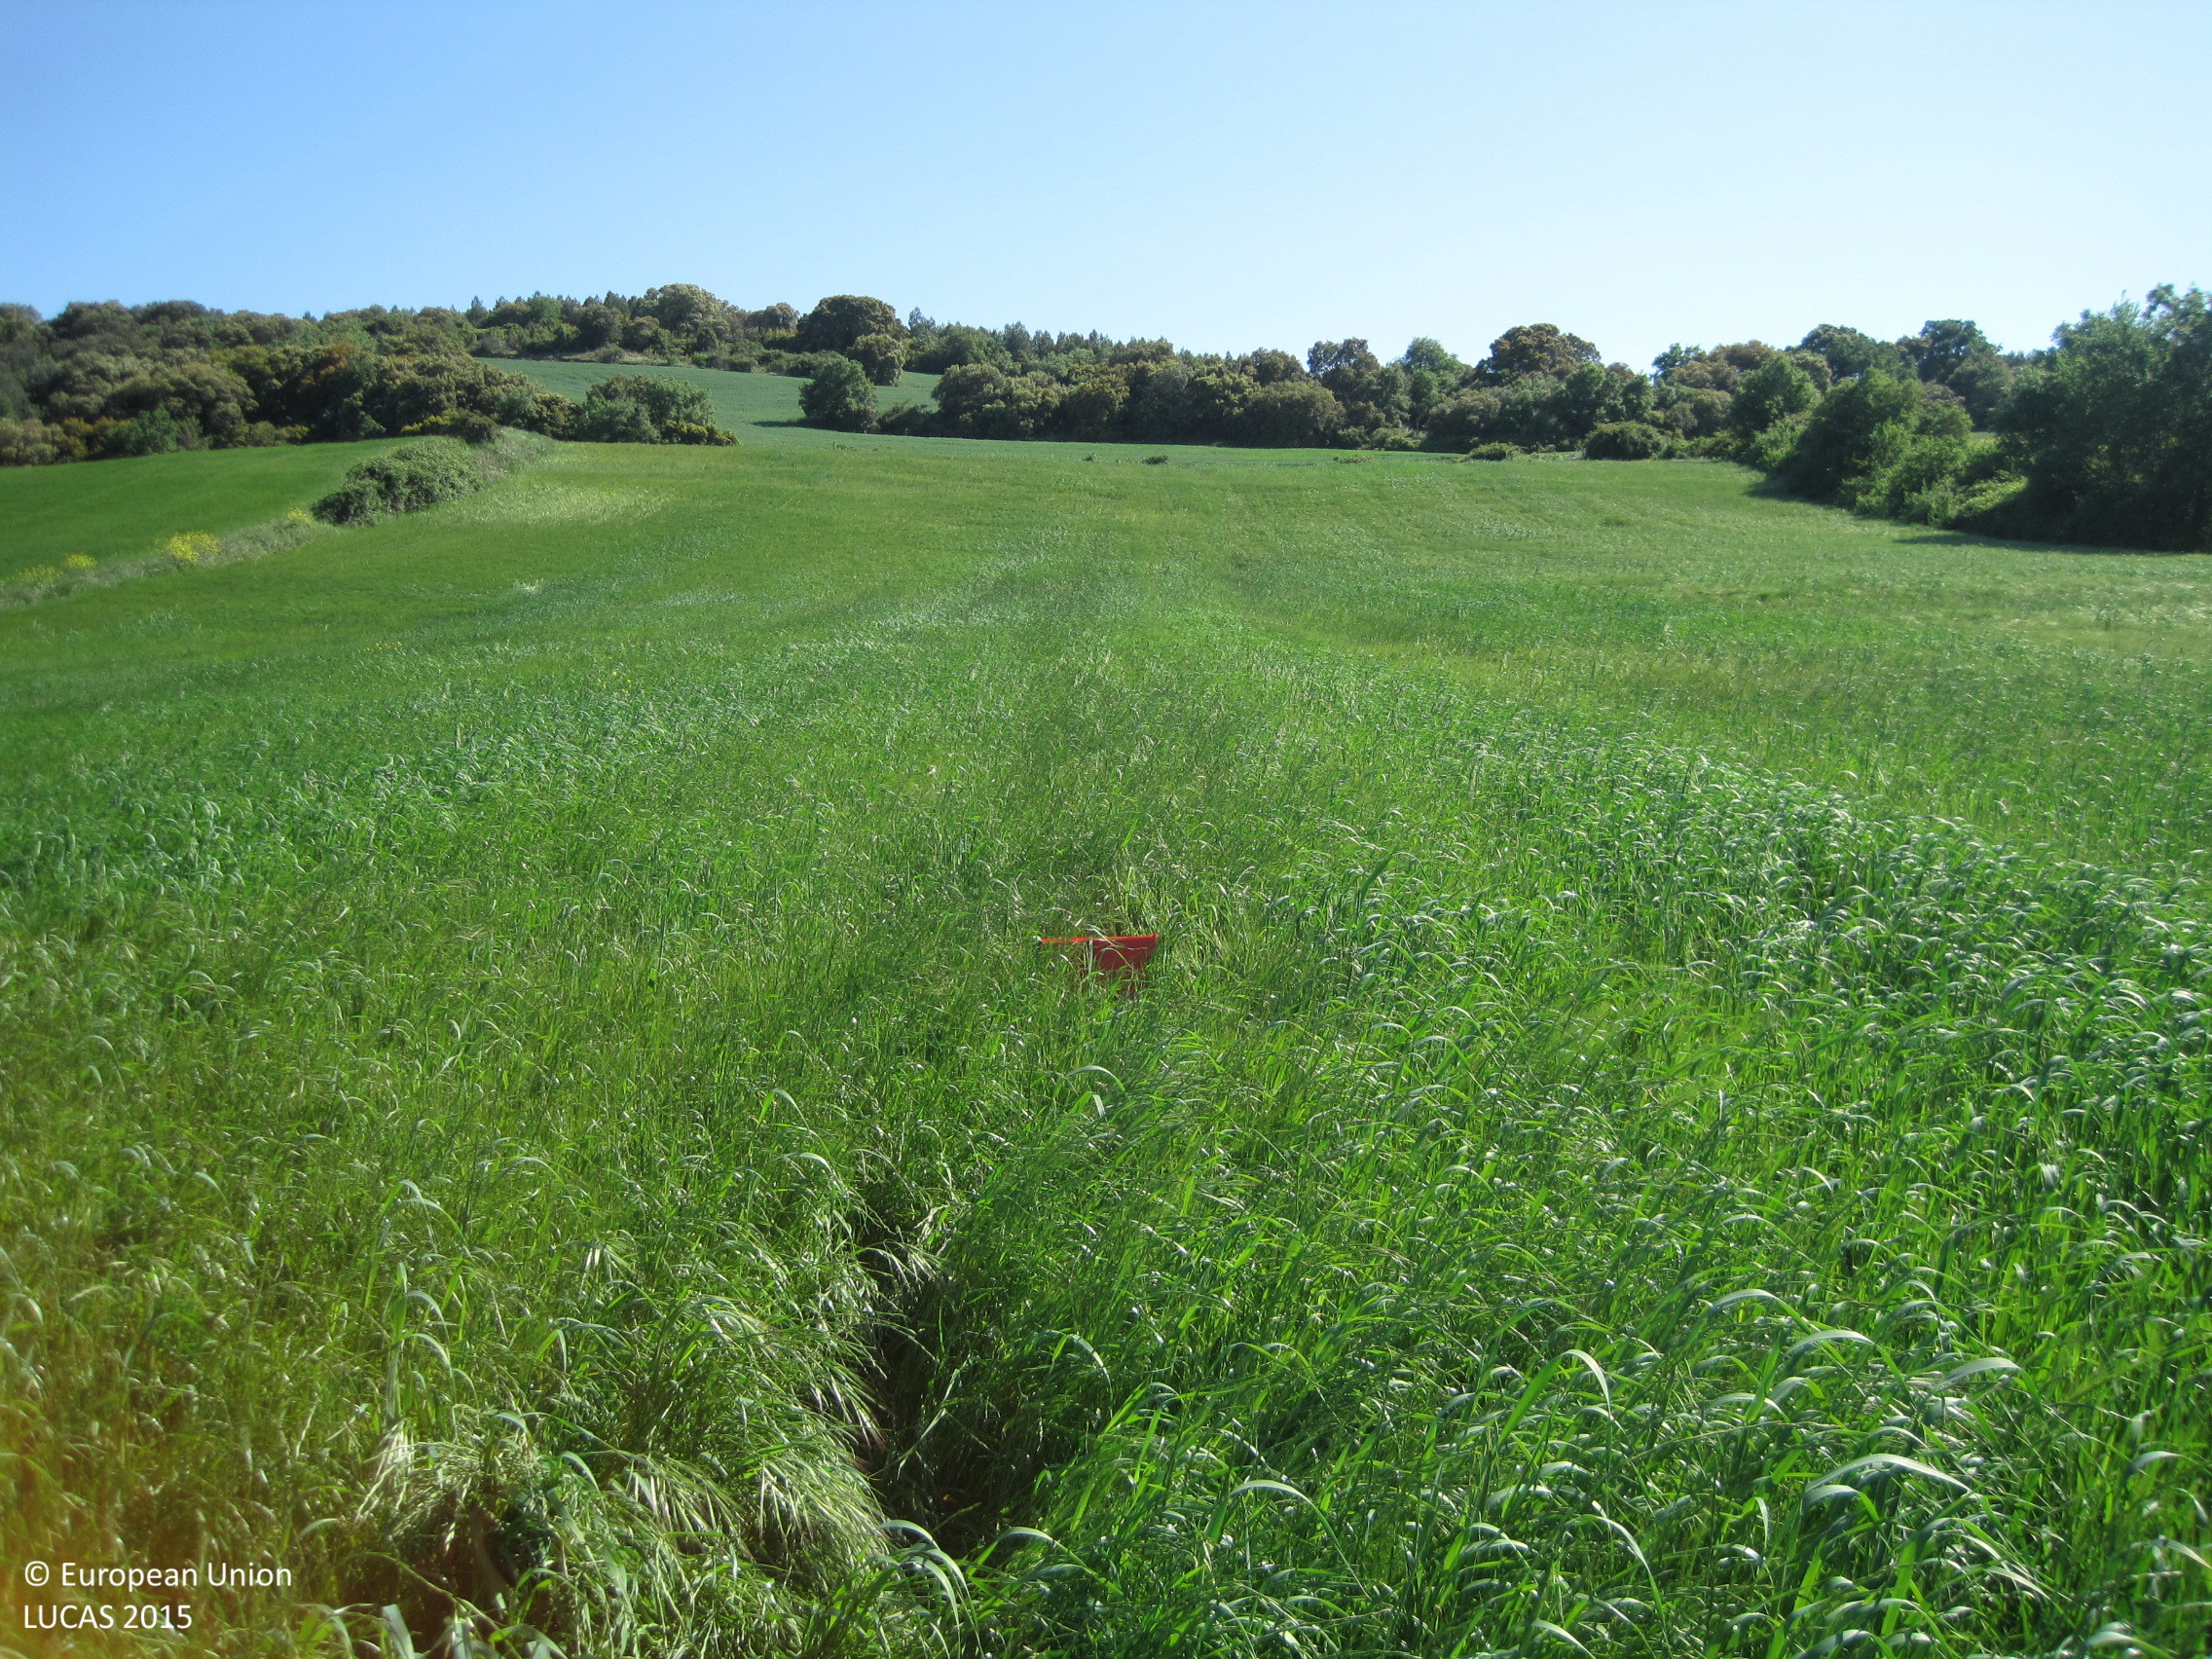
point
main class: Cropland
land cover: Mixed cereals for fodder
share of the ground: > 75 %
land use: Agriculture (excluding fallow land and kitchen gardens)
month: May
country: ES
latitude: 42.5548
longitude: -1.7173
